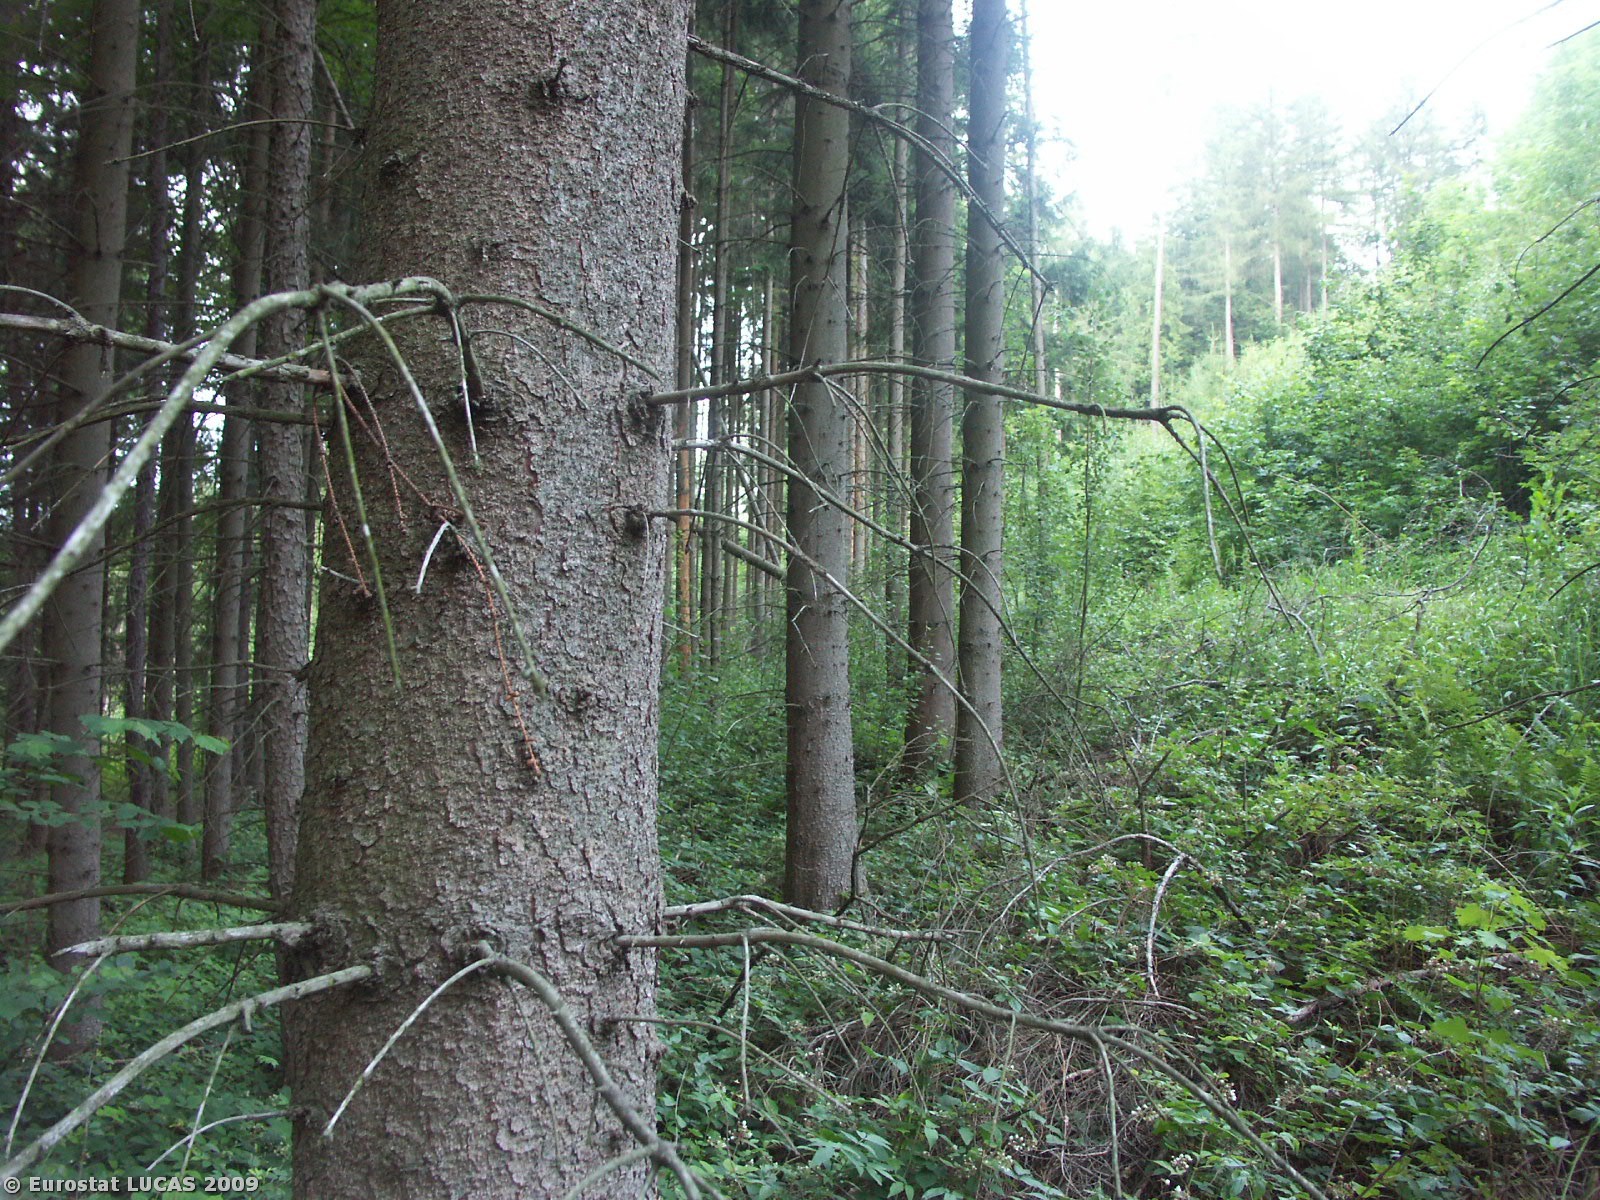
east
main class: Woodland
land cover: Coniferous woodland
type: hemiboreal forest and nemoral coniferous forest and mixed broadleaved-coniferous forest
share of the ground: > 75 %
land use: Forestry
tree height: > 5 m
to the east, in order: Coniferous woodland; Mixed woodland; Tracks; Mixed woodland; Tracks; Mixed woodland
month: July
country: CZ
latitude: 49.9357
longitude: 16.6539
